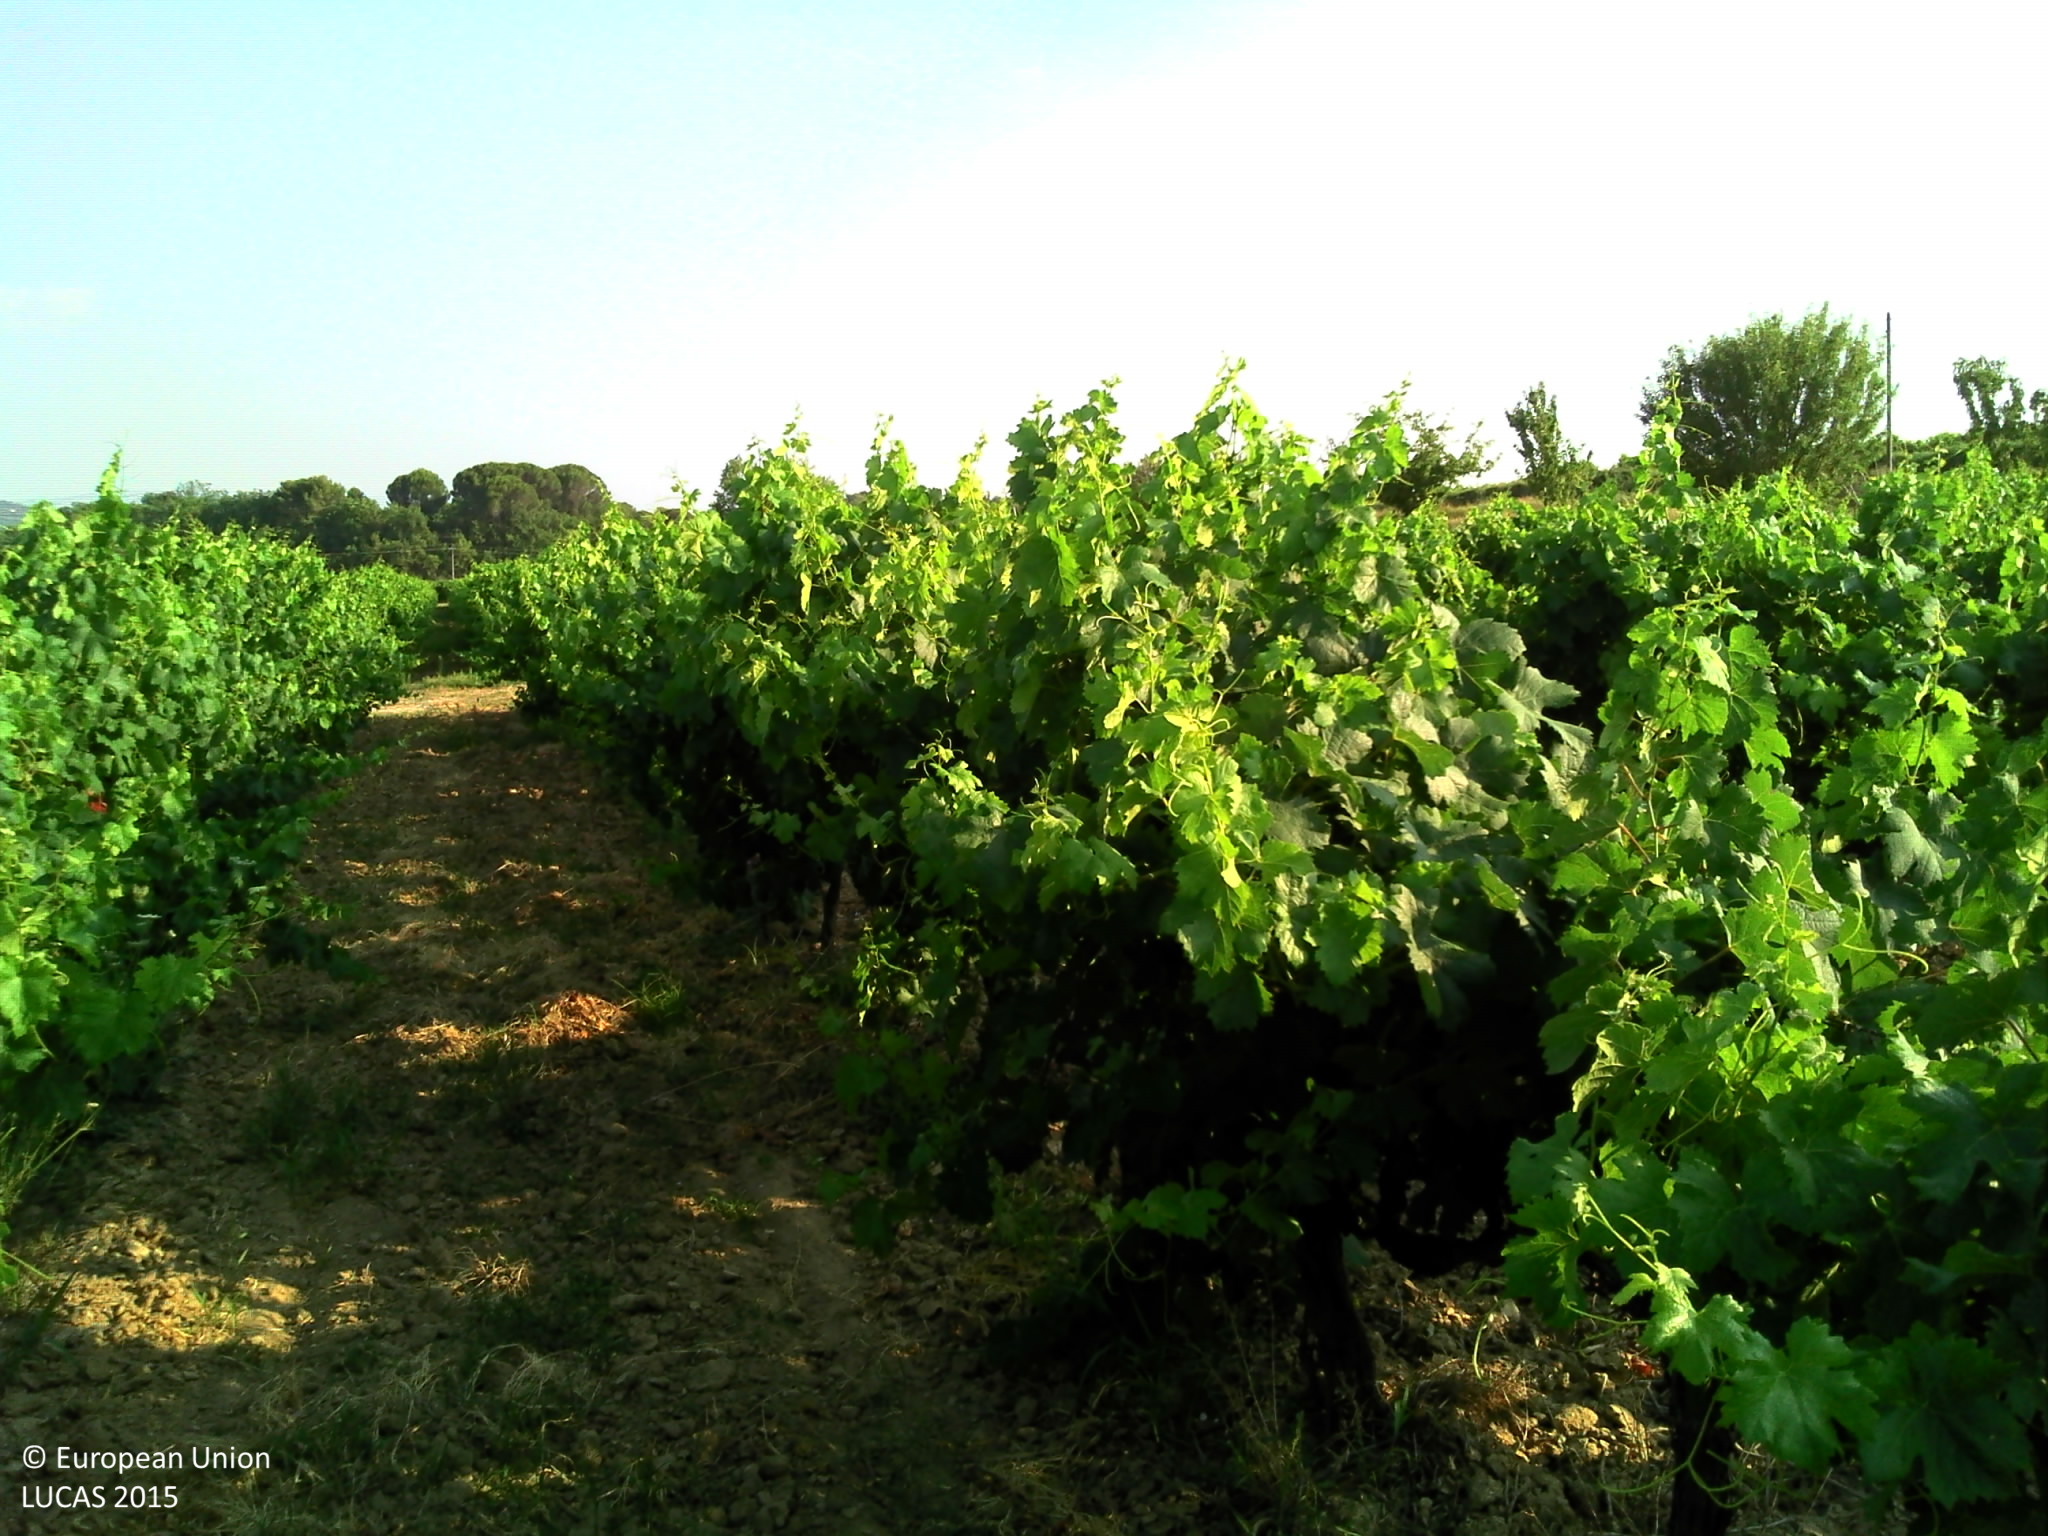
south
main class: Cropland
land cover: Vineyards
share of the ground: 25 - 50 %
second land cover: Other bare soil
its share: > 75 %
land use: Agriculture (excluding fallow land and kitchen gardens)
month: July
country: FR
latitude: 43.7493
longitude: 5.5506
